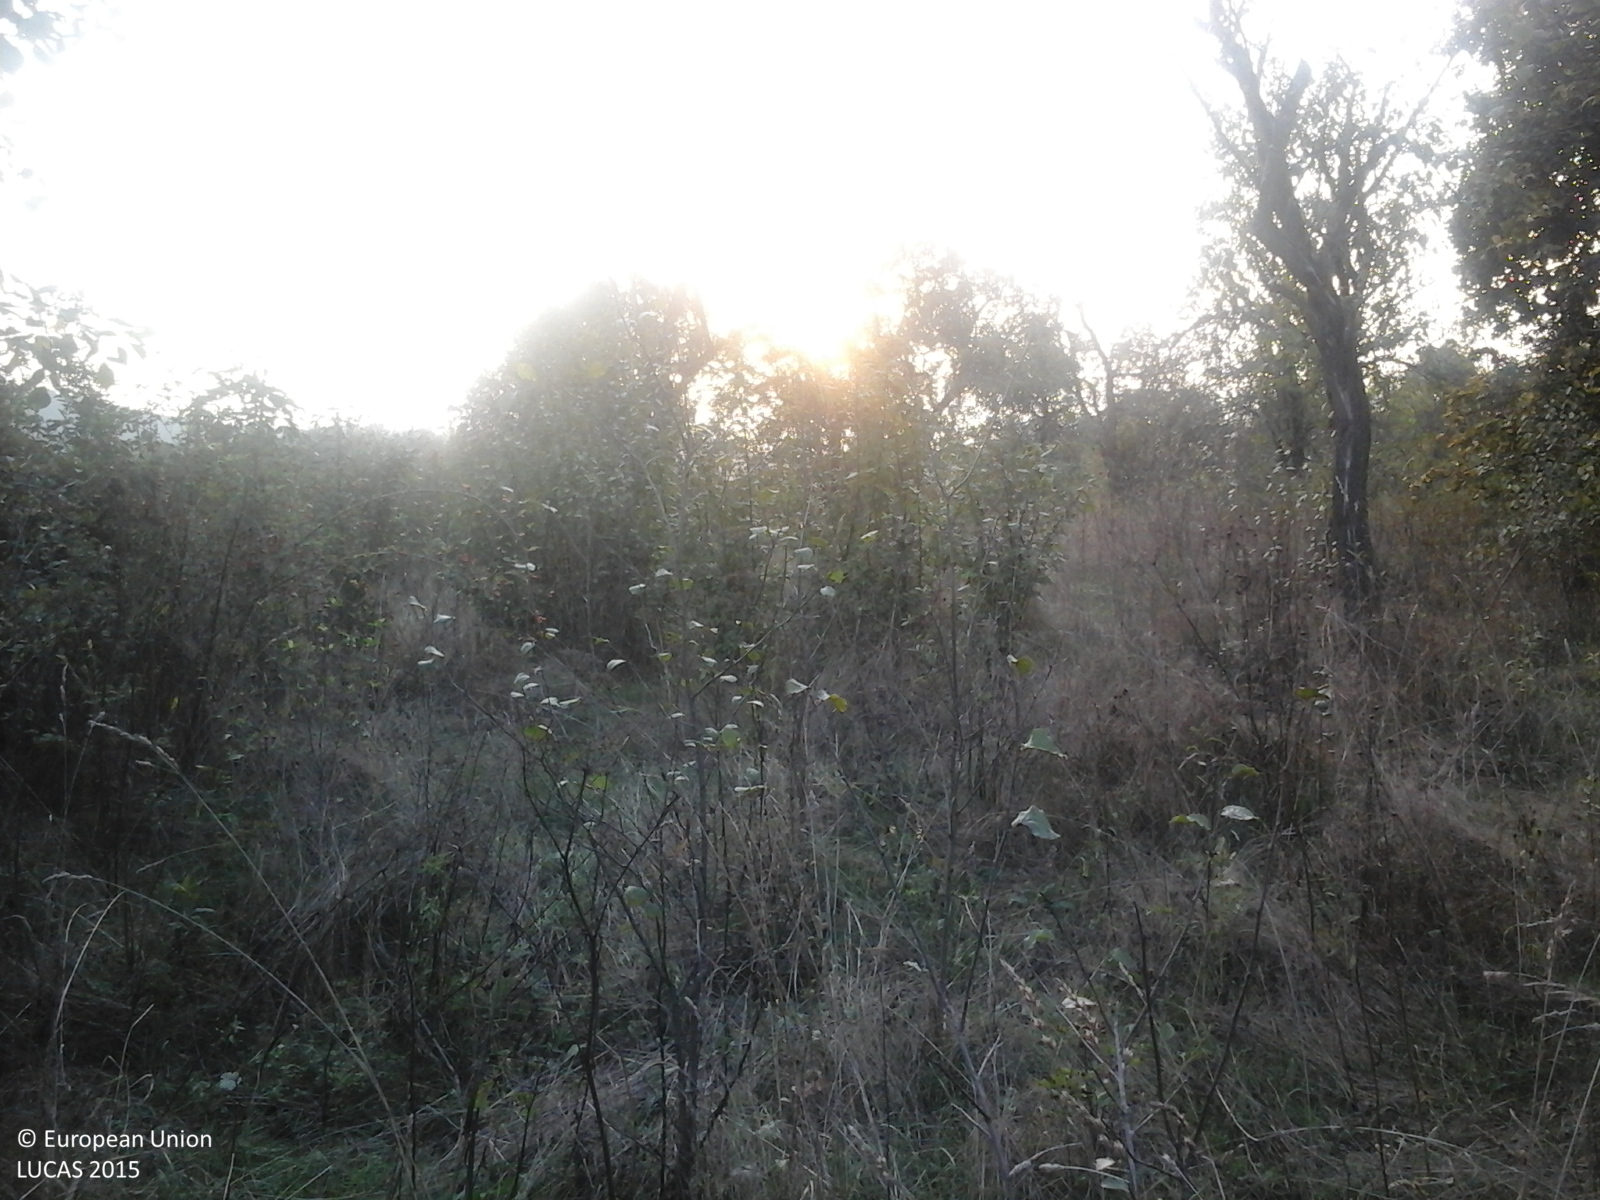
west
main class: Cropland
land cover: Other fruit trees and berries
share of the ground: 50 - 75 %
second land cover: Spontaneously vegetated surfaces
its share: > 75 %
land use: Agriculture (excluding fallow land and kitchen gardens)
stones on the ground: 10 - 25 %
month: September
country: RO
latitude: 45.3216
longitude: 21.8876
